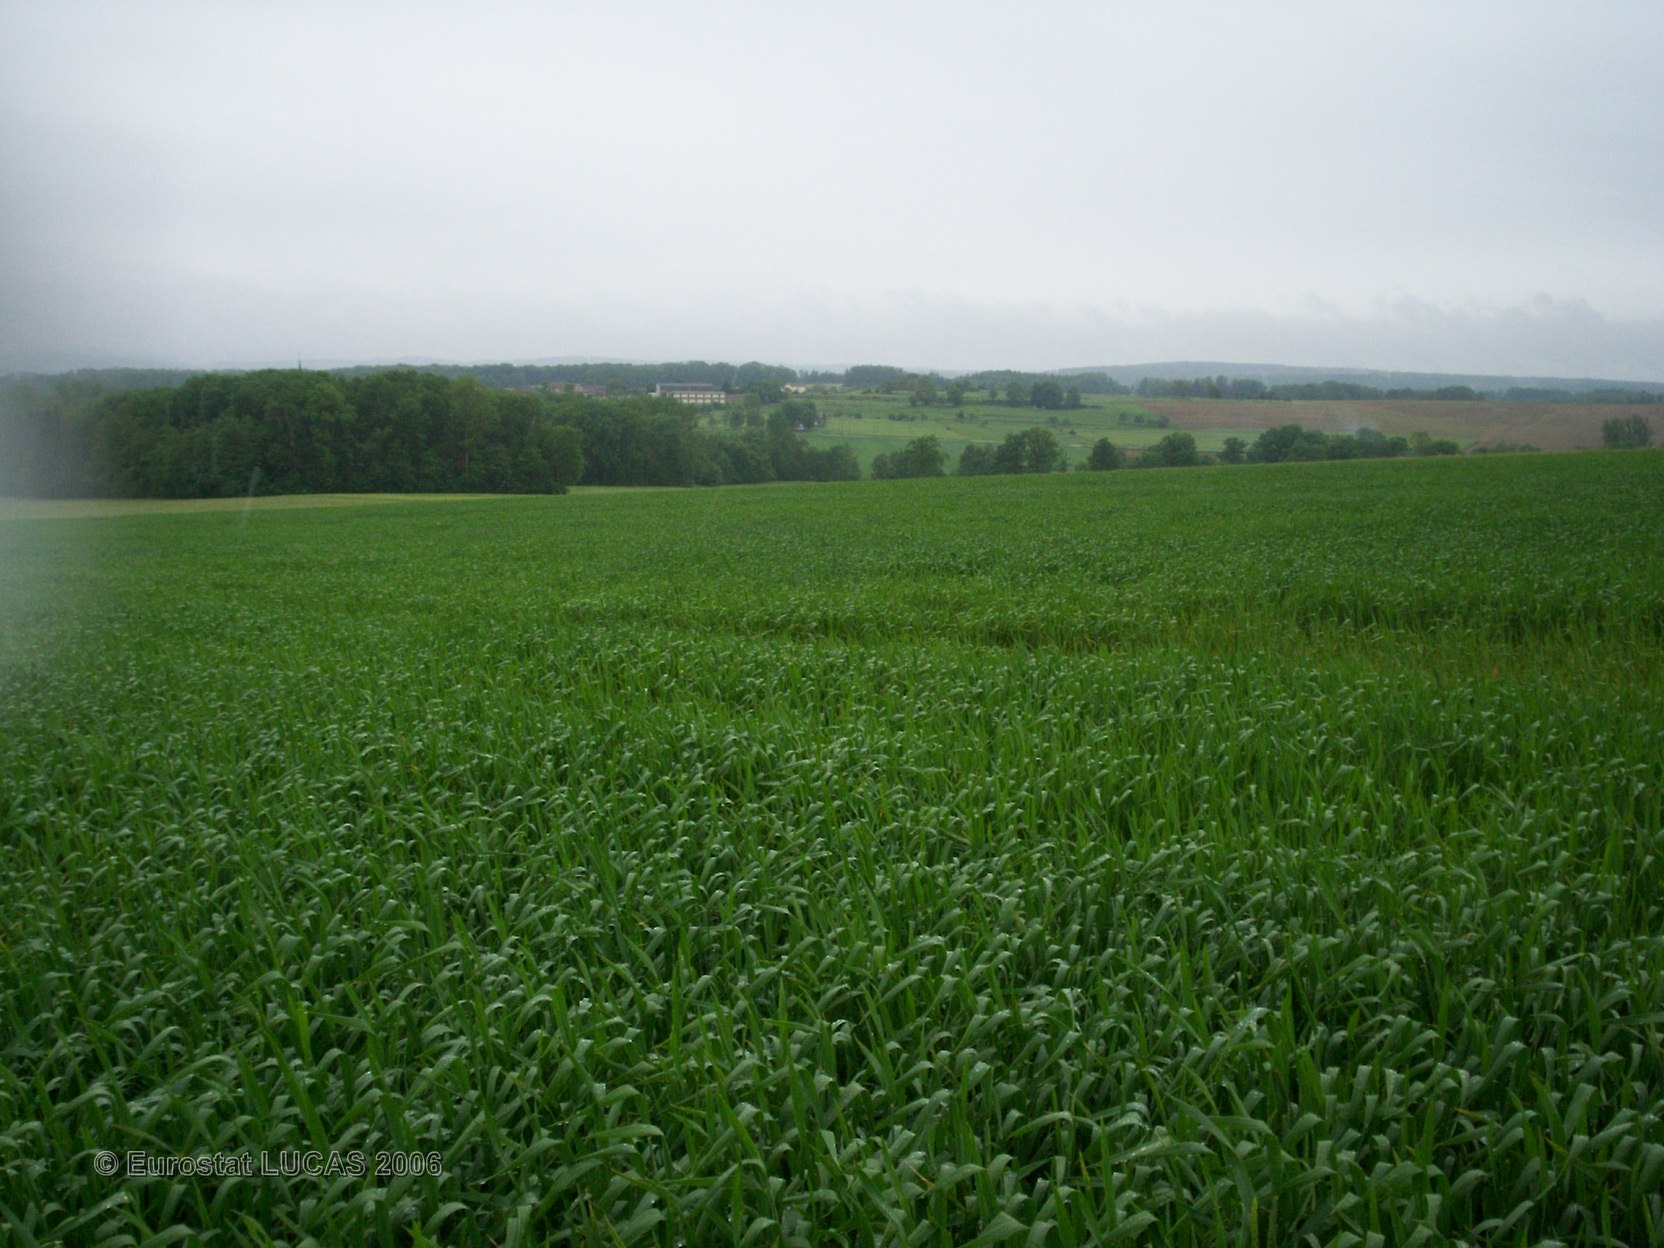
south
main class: Cropland
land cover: Barley
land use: Agriculture (excluding fallow land and kitchen gardens)
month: May
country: FR
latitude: 48.5198
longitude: 6.8190
